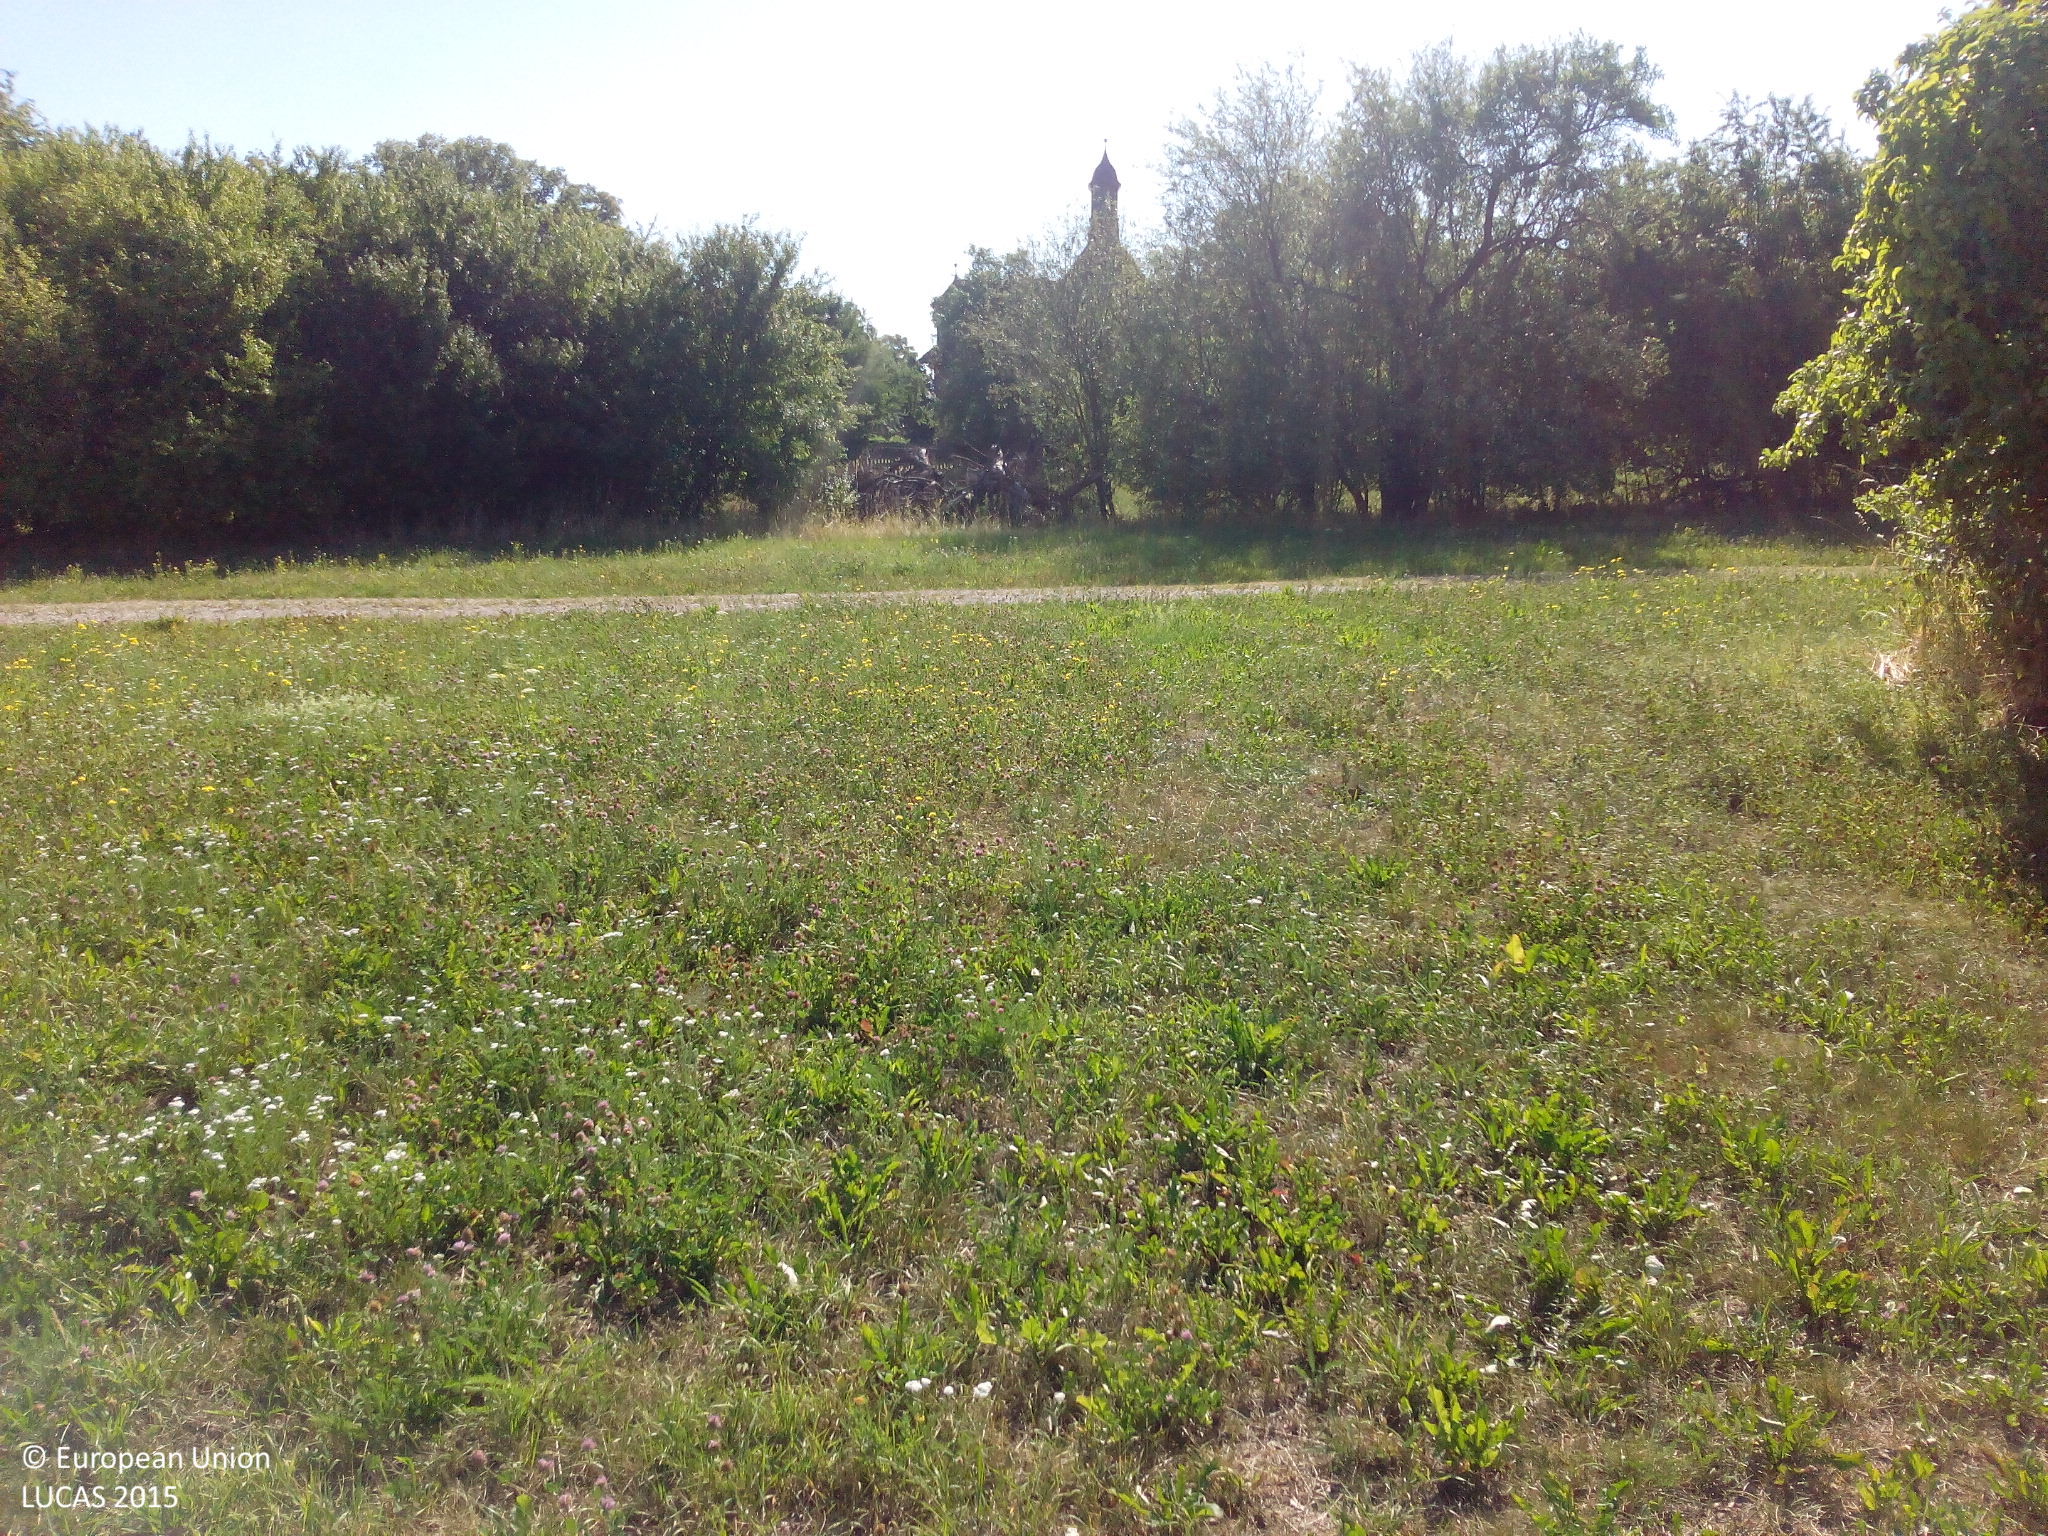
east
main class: Cropland
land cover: Apple fruit
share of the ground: < 10 %
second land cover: Grassland without tree/shrub cover
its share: > 75 %
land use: Agriculture (excluding fallow land and kitchen gardens)
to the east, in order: Apple fruit; Grassland without tree/shrub cover; Tracks; Grassland without tree/shrub cover; Abandoned hedges; Grassland without tree/shrub cover; Tracks; Grassland with sparse tree/shrub cover; Abandoned hedges; Artificial constructions in urban areas; Abandoned hedges; Grassland without tree/shrub cover; Tracks; Grassland without tree/shrub cover; Tracks; Grassland with sparse tree/shrub cover; Tracks; Grassland with sparse tree/shrub cover
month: July
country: DE
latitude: 49.4071
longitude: 10.9230
